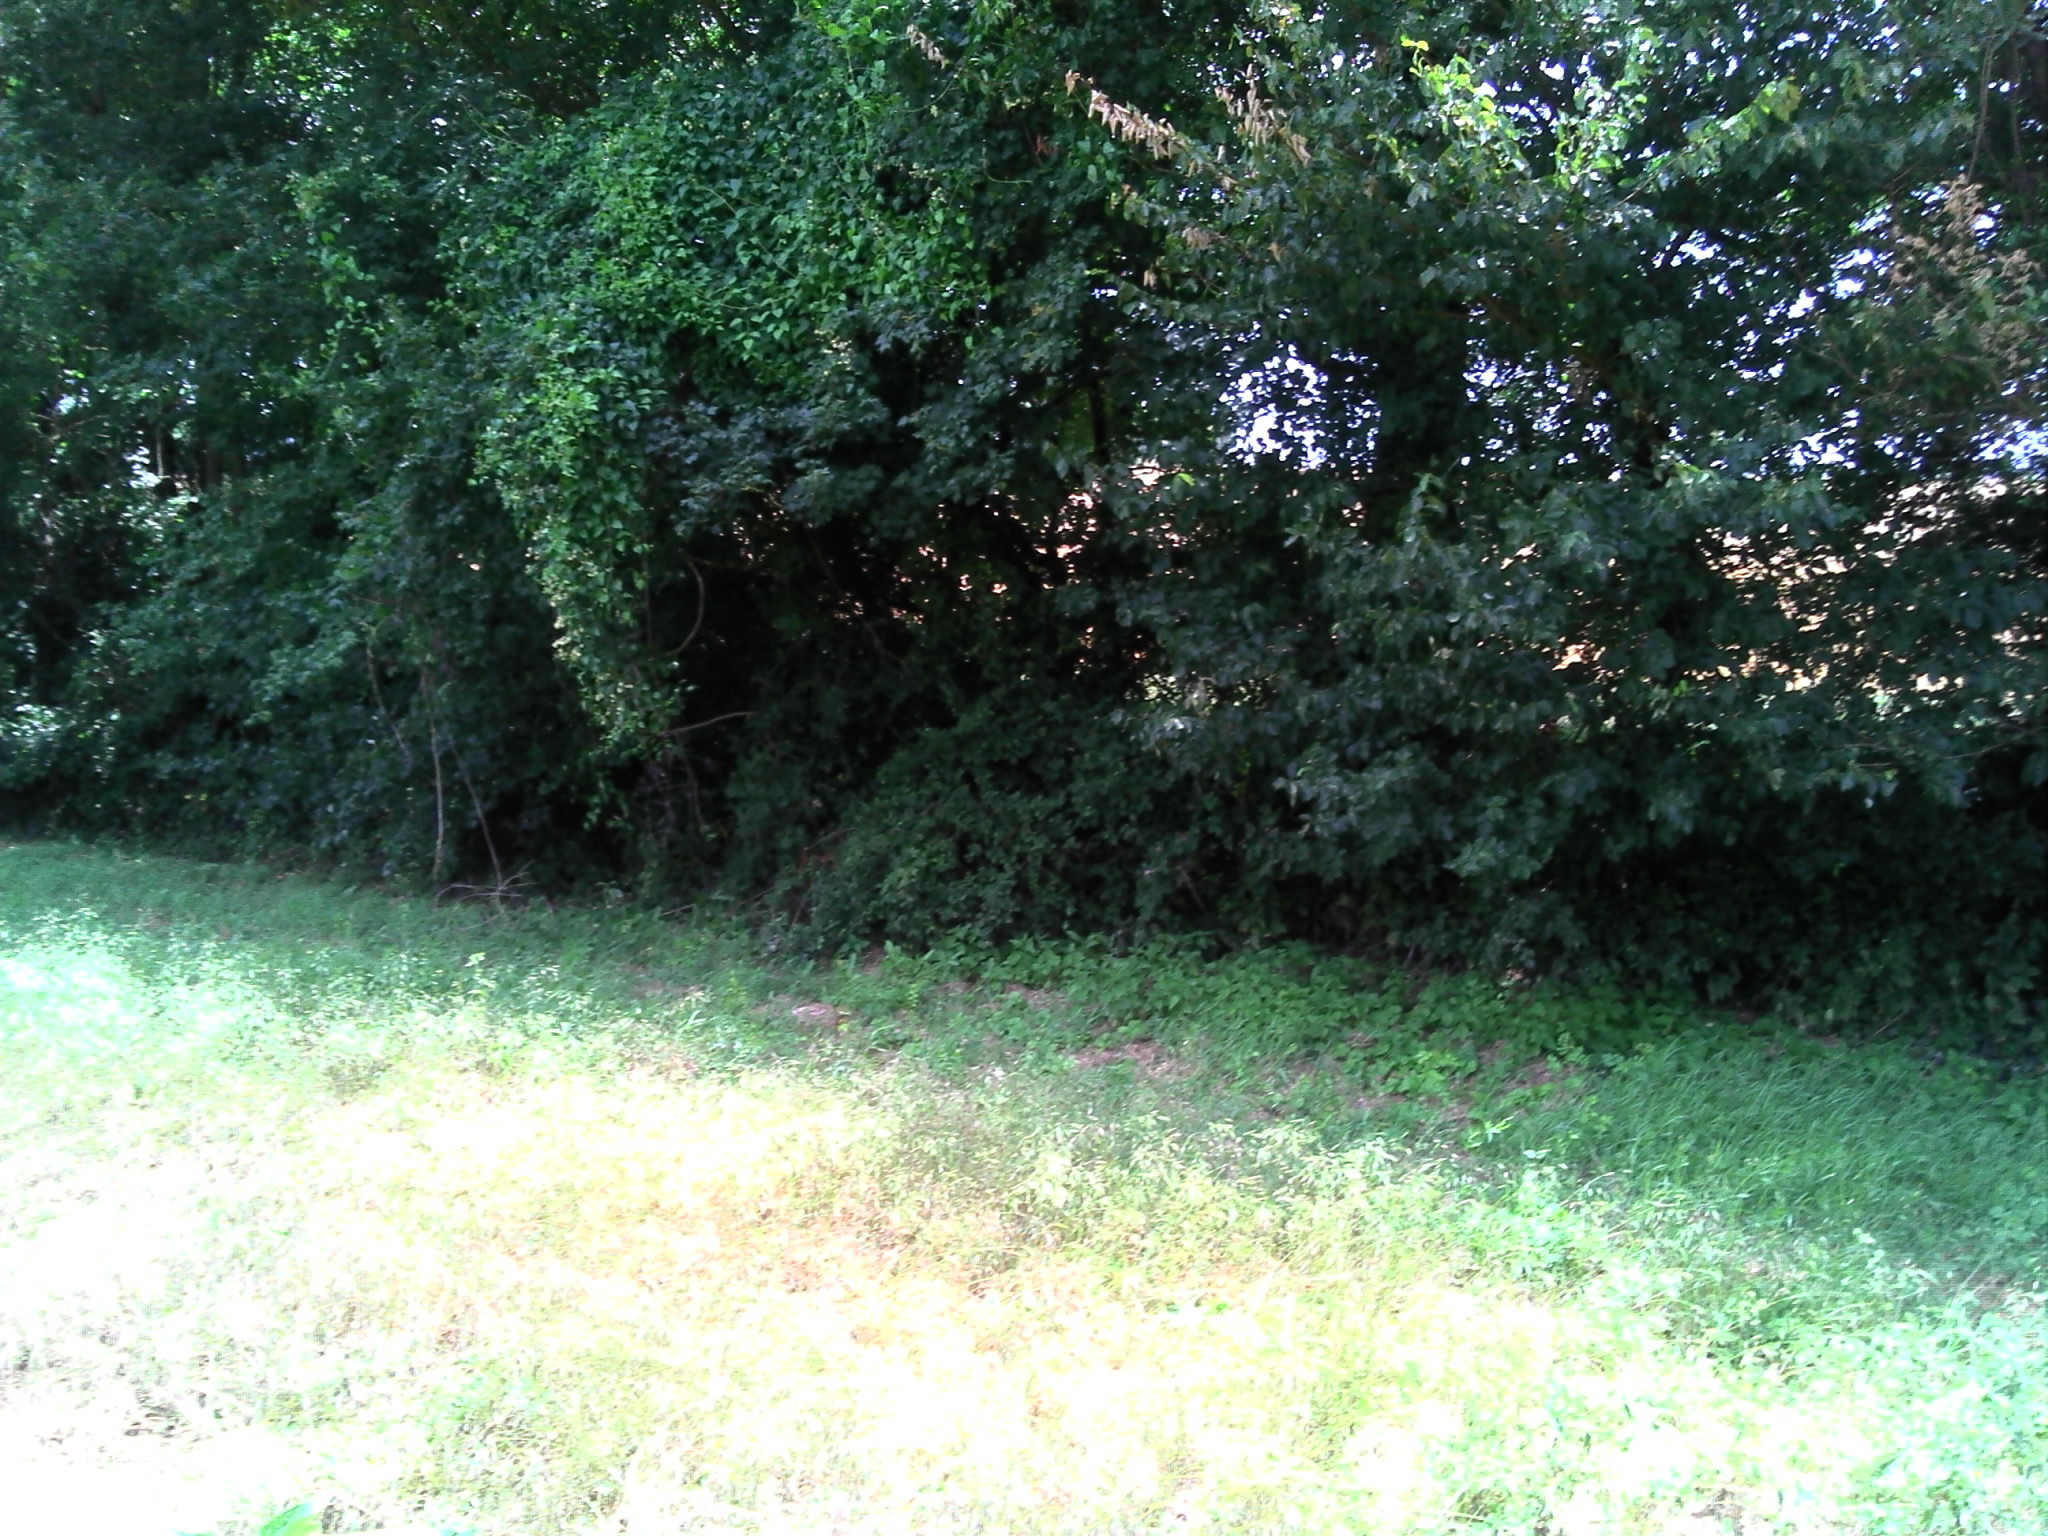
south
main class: Cropland
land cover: Sunflower
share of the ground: > 75 %
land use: Agriculture (excluding fallow land and kitchen gardens)
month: July
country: FR
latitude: 43.5282
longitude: 1.0552
